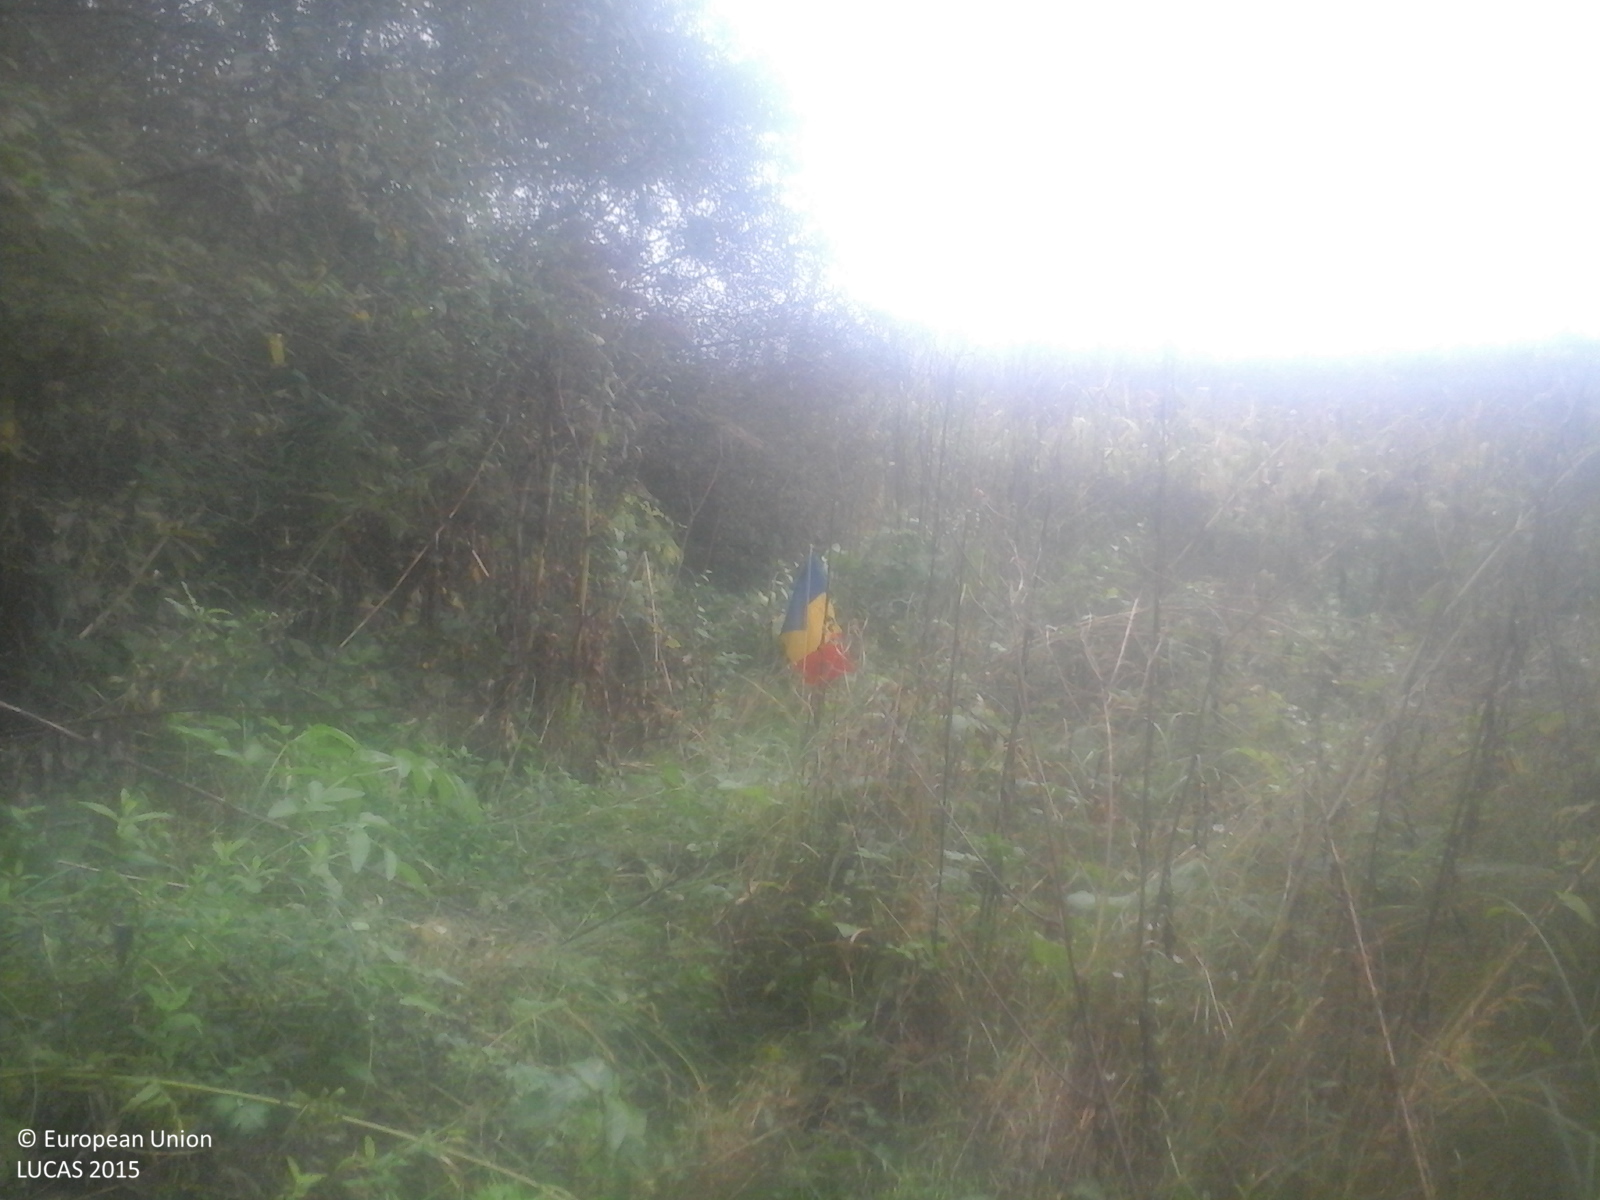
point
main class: Grassland
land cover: Spontaneously vegetated surfaces
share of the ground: > 75 %
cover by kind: herbaceous plants 100 %
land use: Fallow land
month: September
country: RO
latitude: 44.8186
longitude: 23.1901
